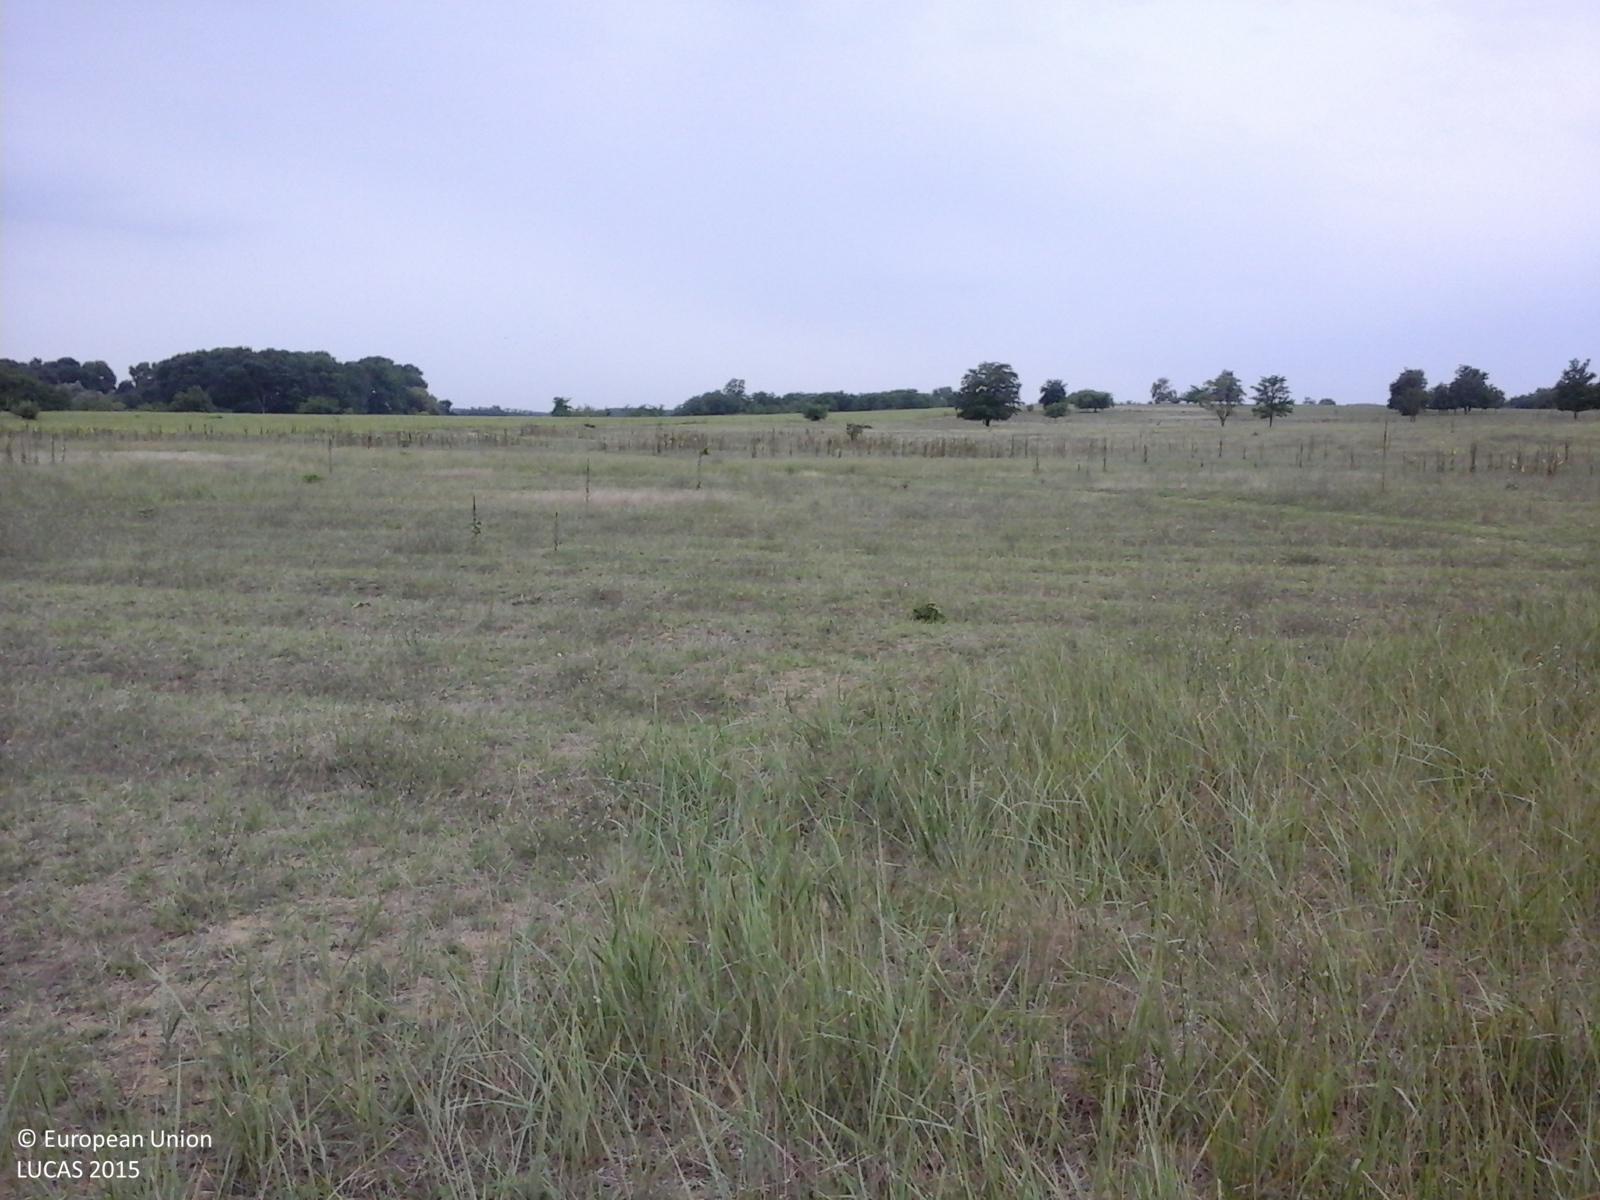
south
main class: Grassland
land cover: Spontaneously vegetated surfaces
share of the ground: > 75 %
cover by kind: herbaceous plants 100 %
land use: Fallow land
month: September
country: RO
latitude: 47.5389
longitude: 22.0738
